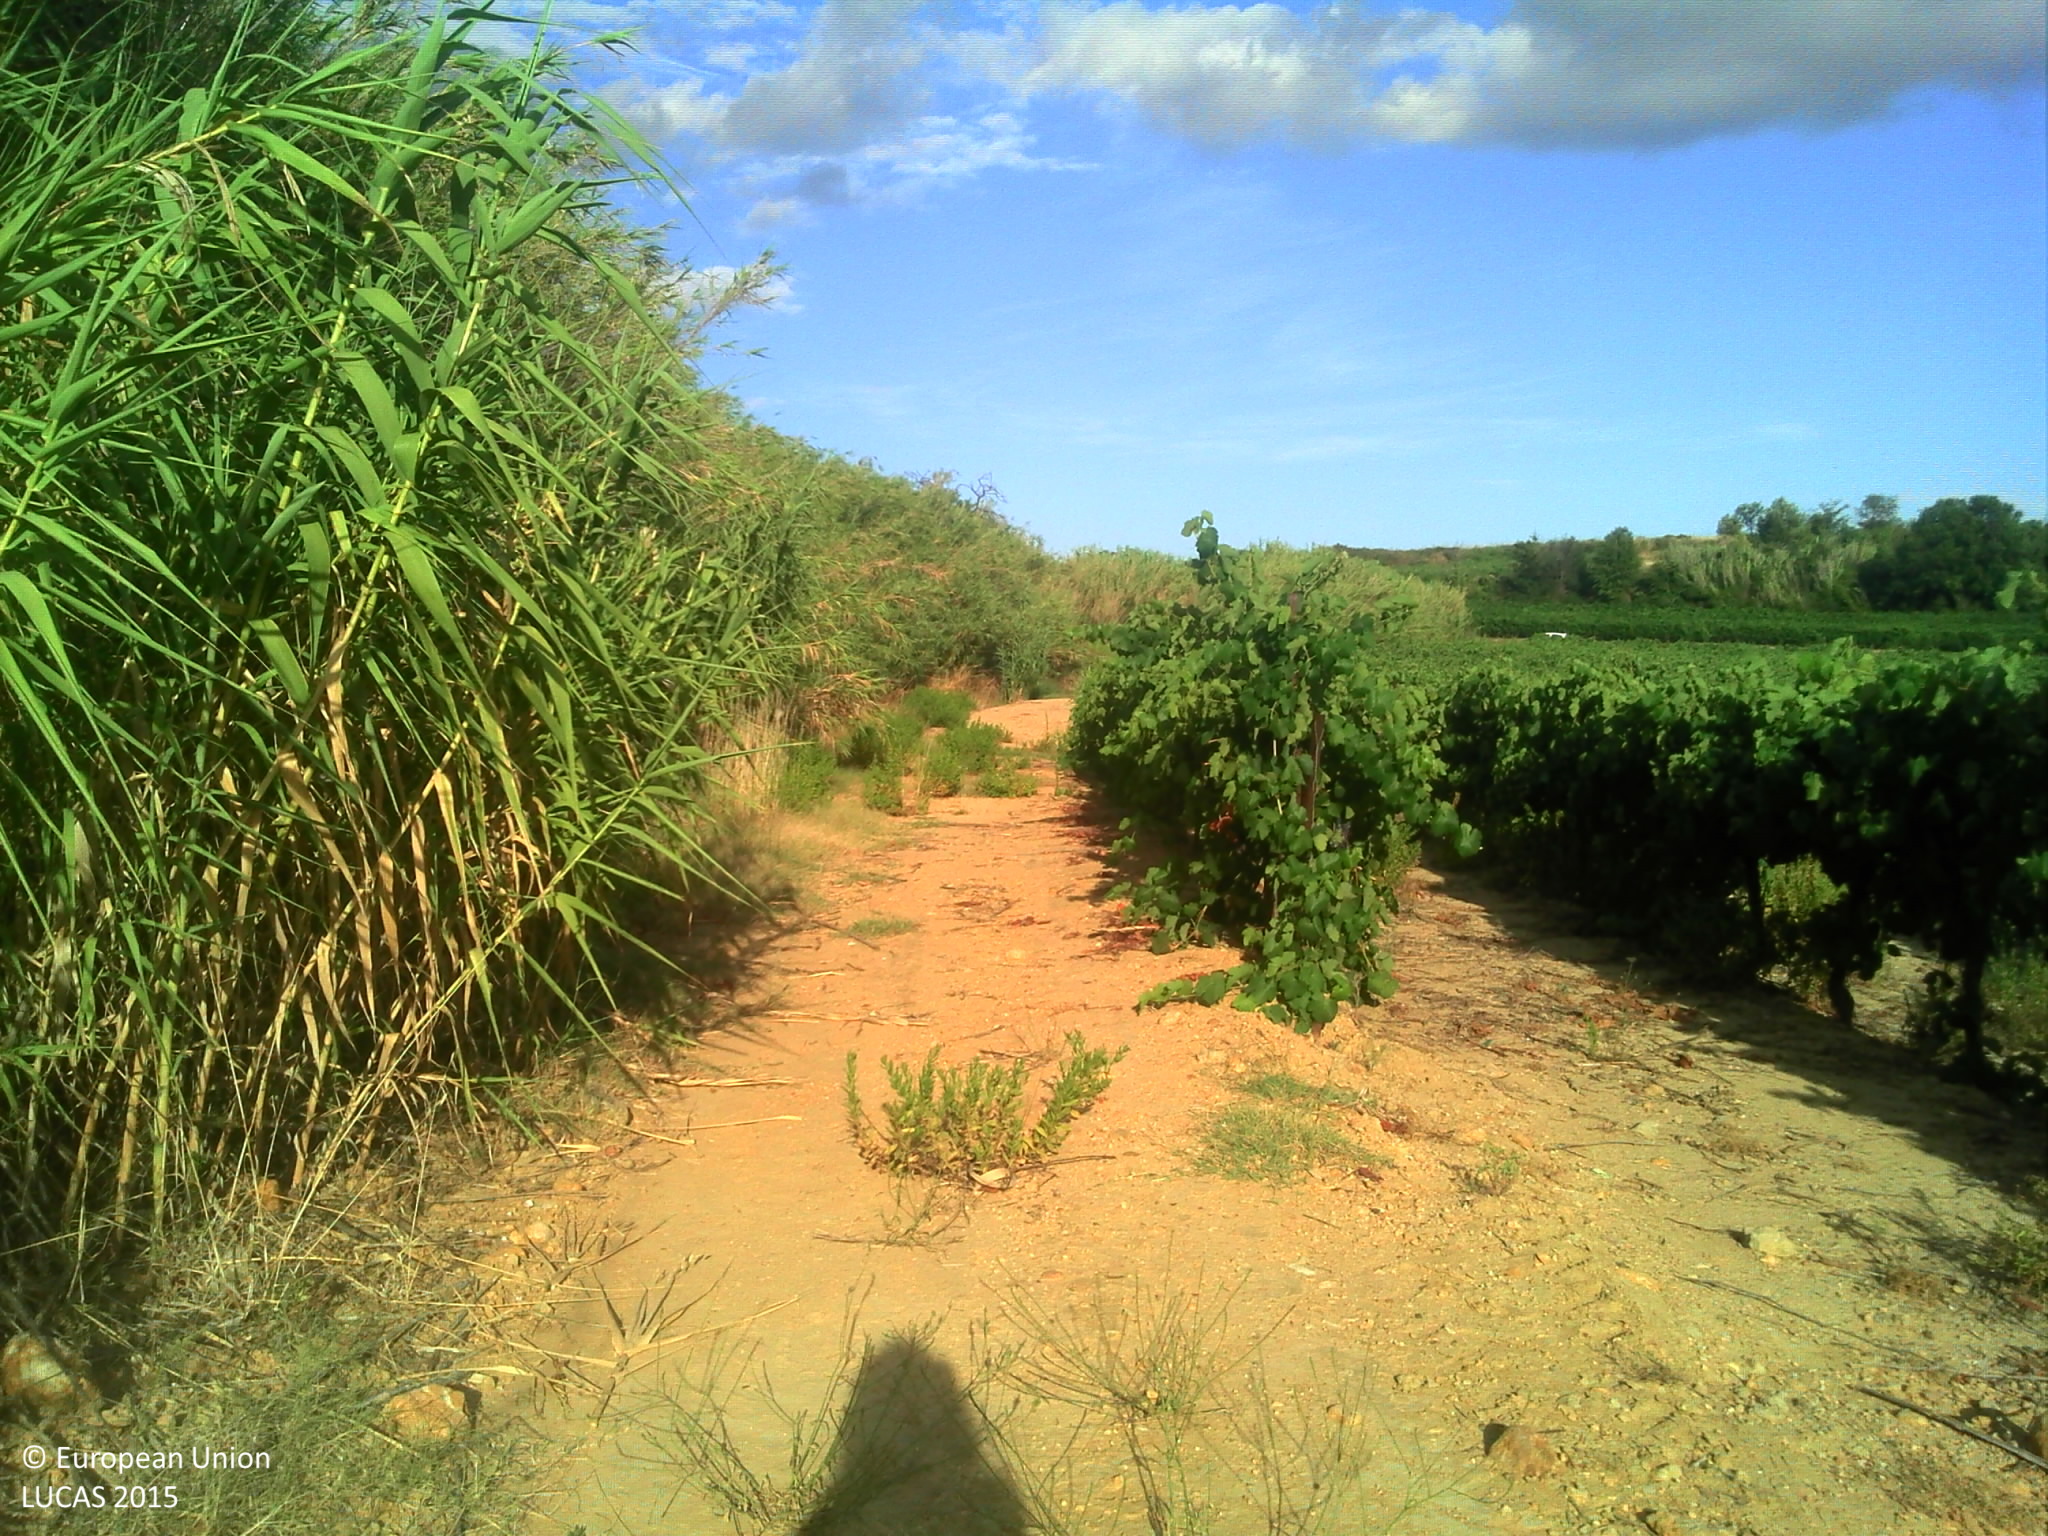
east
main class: Grassland
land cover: Spontaneously vegetated surfaces
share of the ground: > 75 %
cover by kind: herbaceous plants 90 %, shrubs 5 %, lichens and mosses 5 %
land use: Abandoned areas
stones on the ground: 25 - 50 %
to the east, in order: Spontaneously vegetated surfaces; Tracks; Spontaneously vegetated surfaces; Tracks; Vineyards; Lines of trees; Tracks; Grassland without tree/shrub cover; Single bushes/trees; Grassland without tree/shrub cover
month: July
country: FR
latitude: 43.3955
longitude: 3.0827
